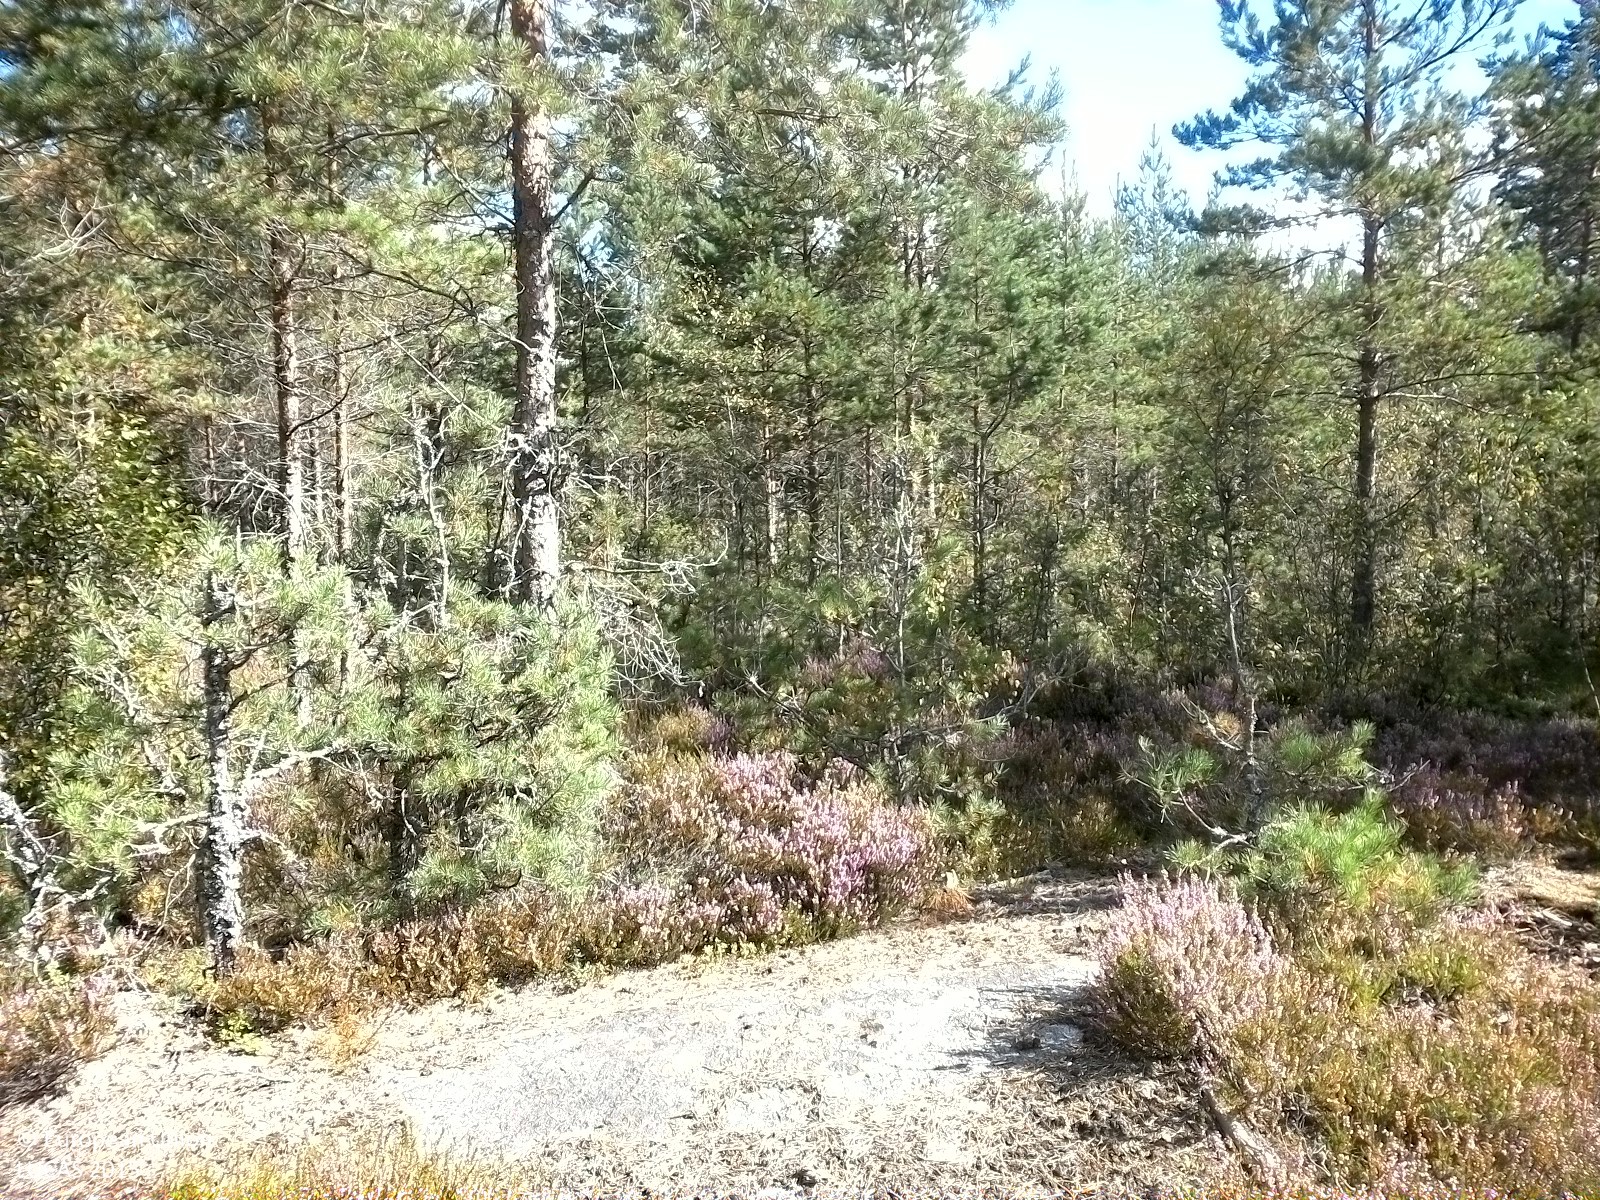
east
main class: Shrubland
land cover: Shrubland with sparse tree cover
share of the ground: 50 - 75 %
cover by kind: shrubs 70 %, lichens and mosses 20 %, coniferous forest trees 5 %, herbaceous plants 5 %
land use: Semi-natural and natural areas not in use
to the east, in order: Shrubland with sparse tree cover; Pine dominated mixed woodland; Other mixed woodland; Other coniferous woodland
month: August
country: SE
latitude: 59.0730
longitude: 15.6970
